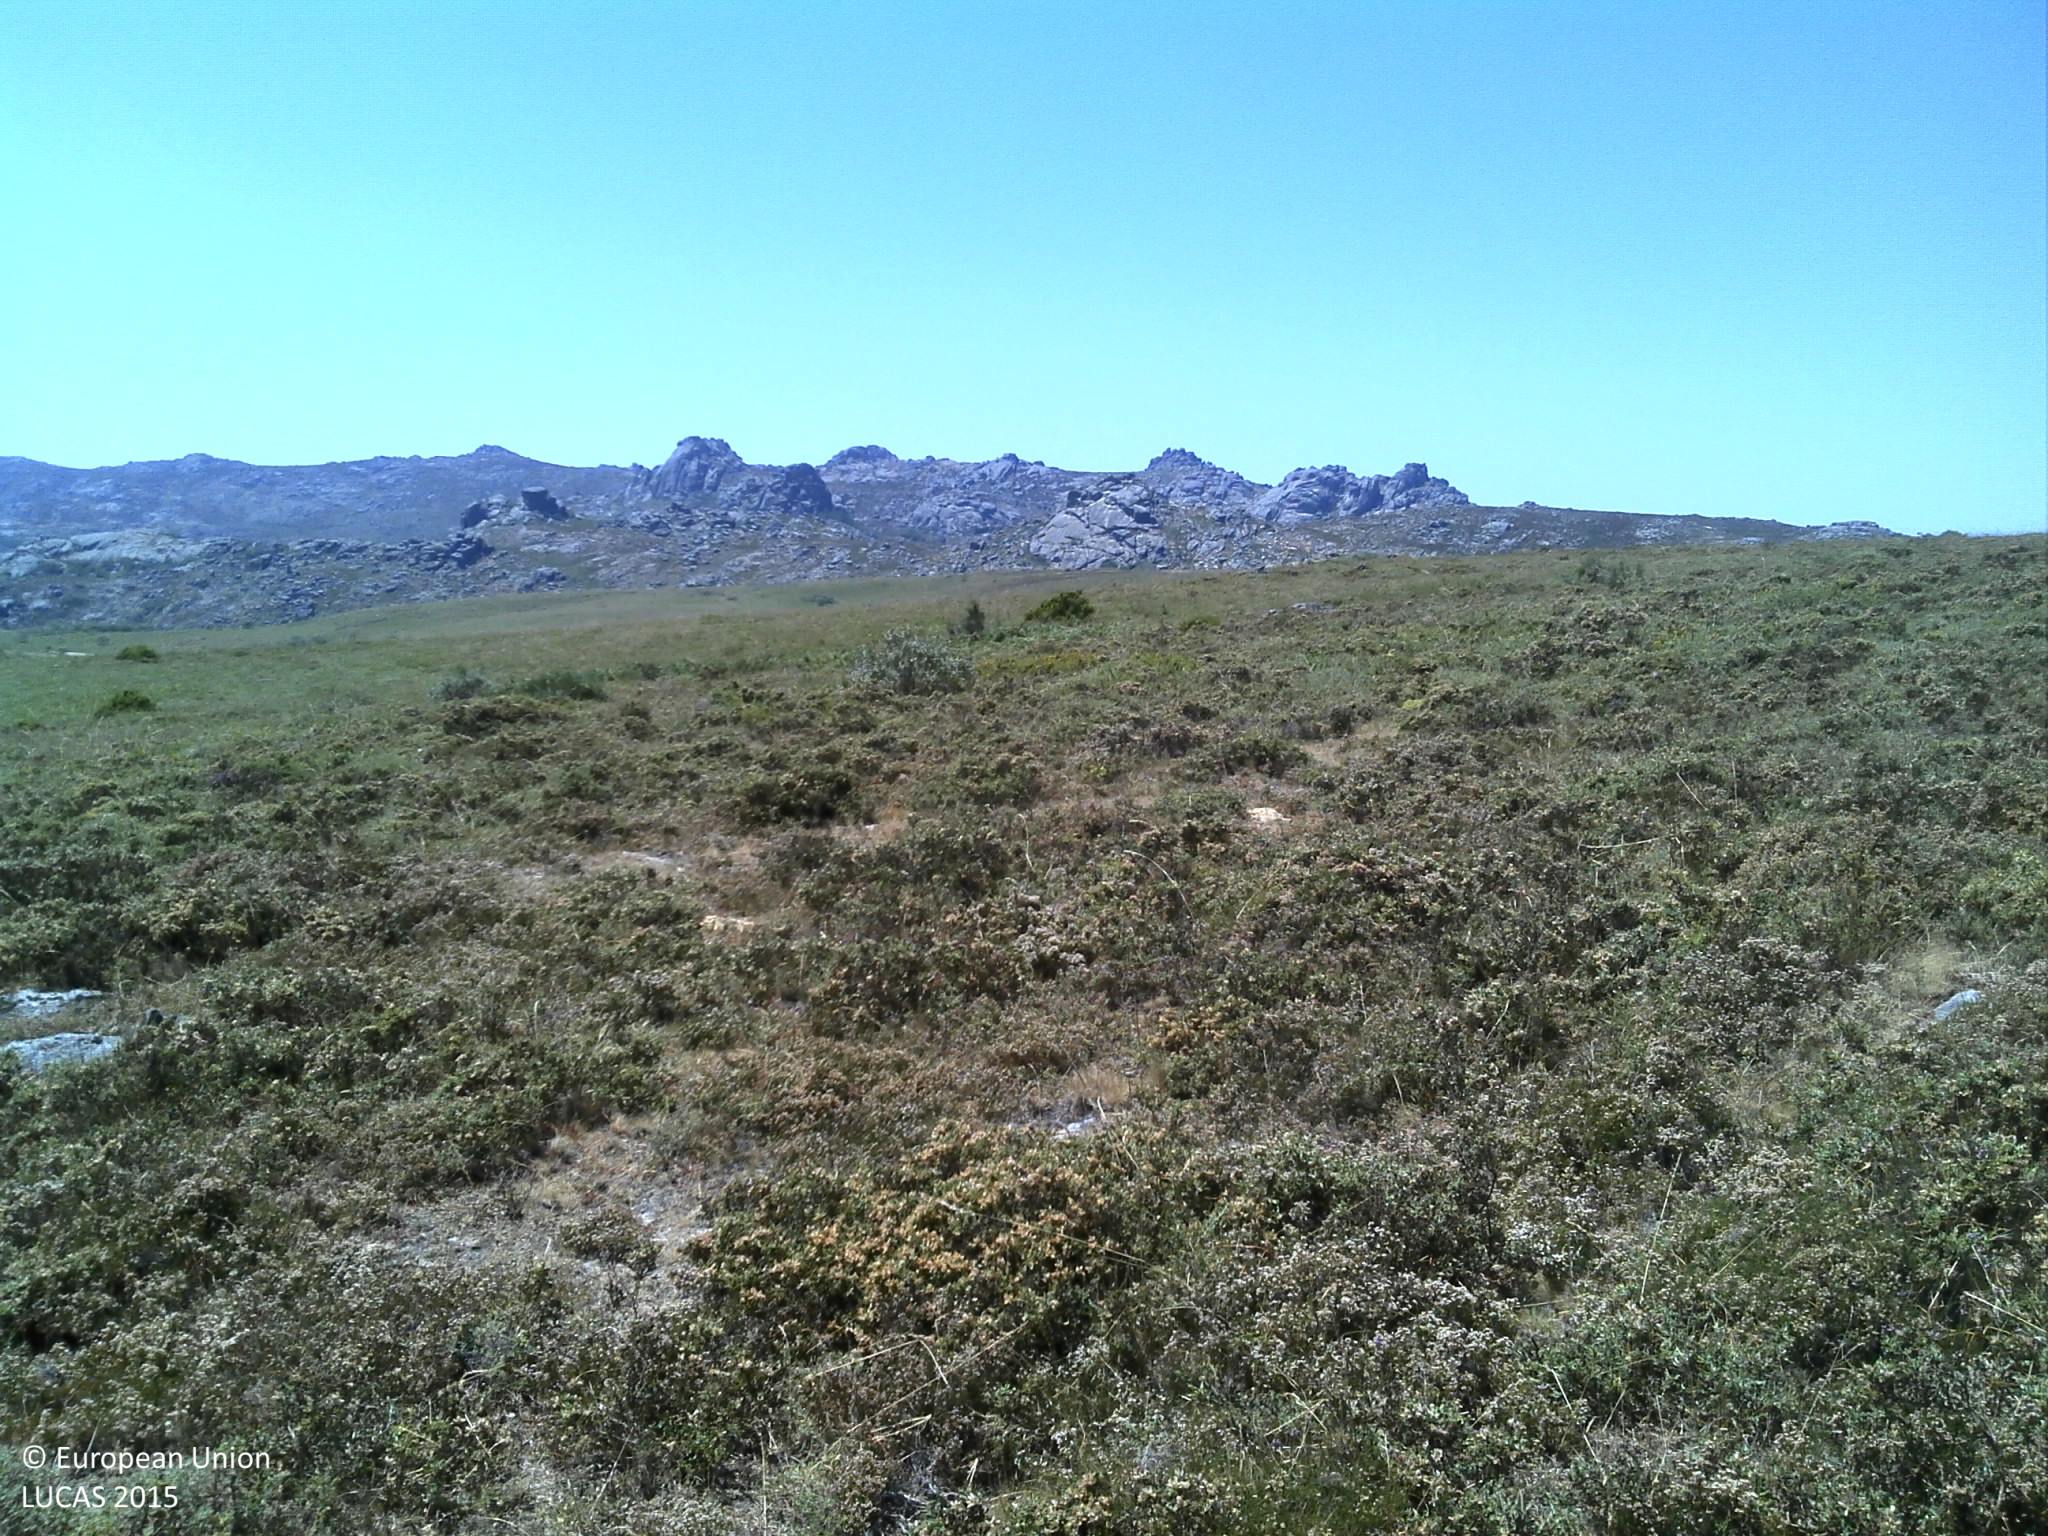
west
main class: Shrubland
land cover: Shrubland without tree cover
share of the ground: 50 - 75 %
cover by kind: shrubs 75 %, herbaceous plants 15 %, unconsolidated bare surface 10 %
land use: Agriculture (excluding fallow land and kitchen gardens)
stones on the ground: 25 - 50 %
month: July
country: PT
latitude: 41.8673
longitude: -7.9395
